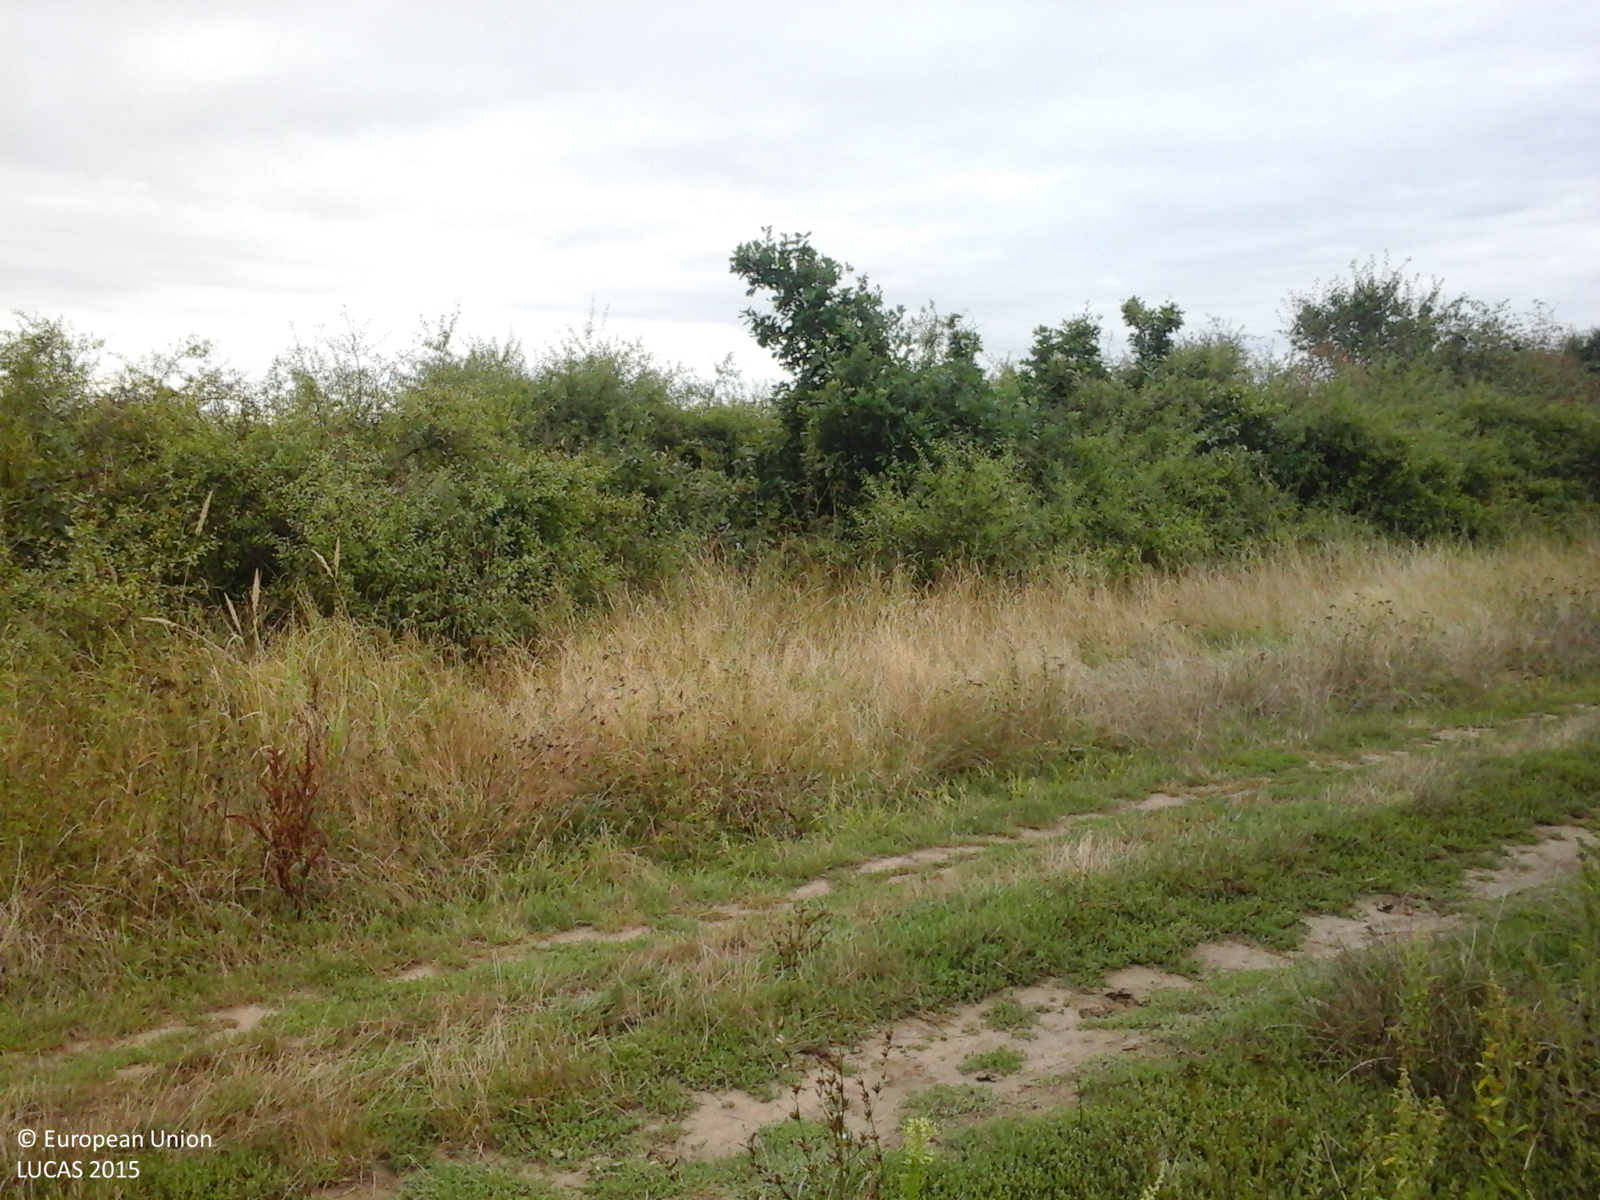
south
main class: Cropland
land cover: Sunflower
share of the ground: > 75 %
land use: Agriculture (excluding fallow land and kitchen gardens)
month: September
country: RO
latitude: 46.8353
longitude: 21.8572
